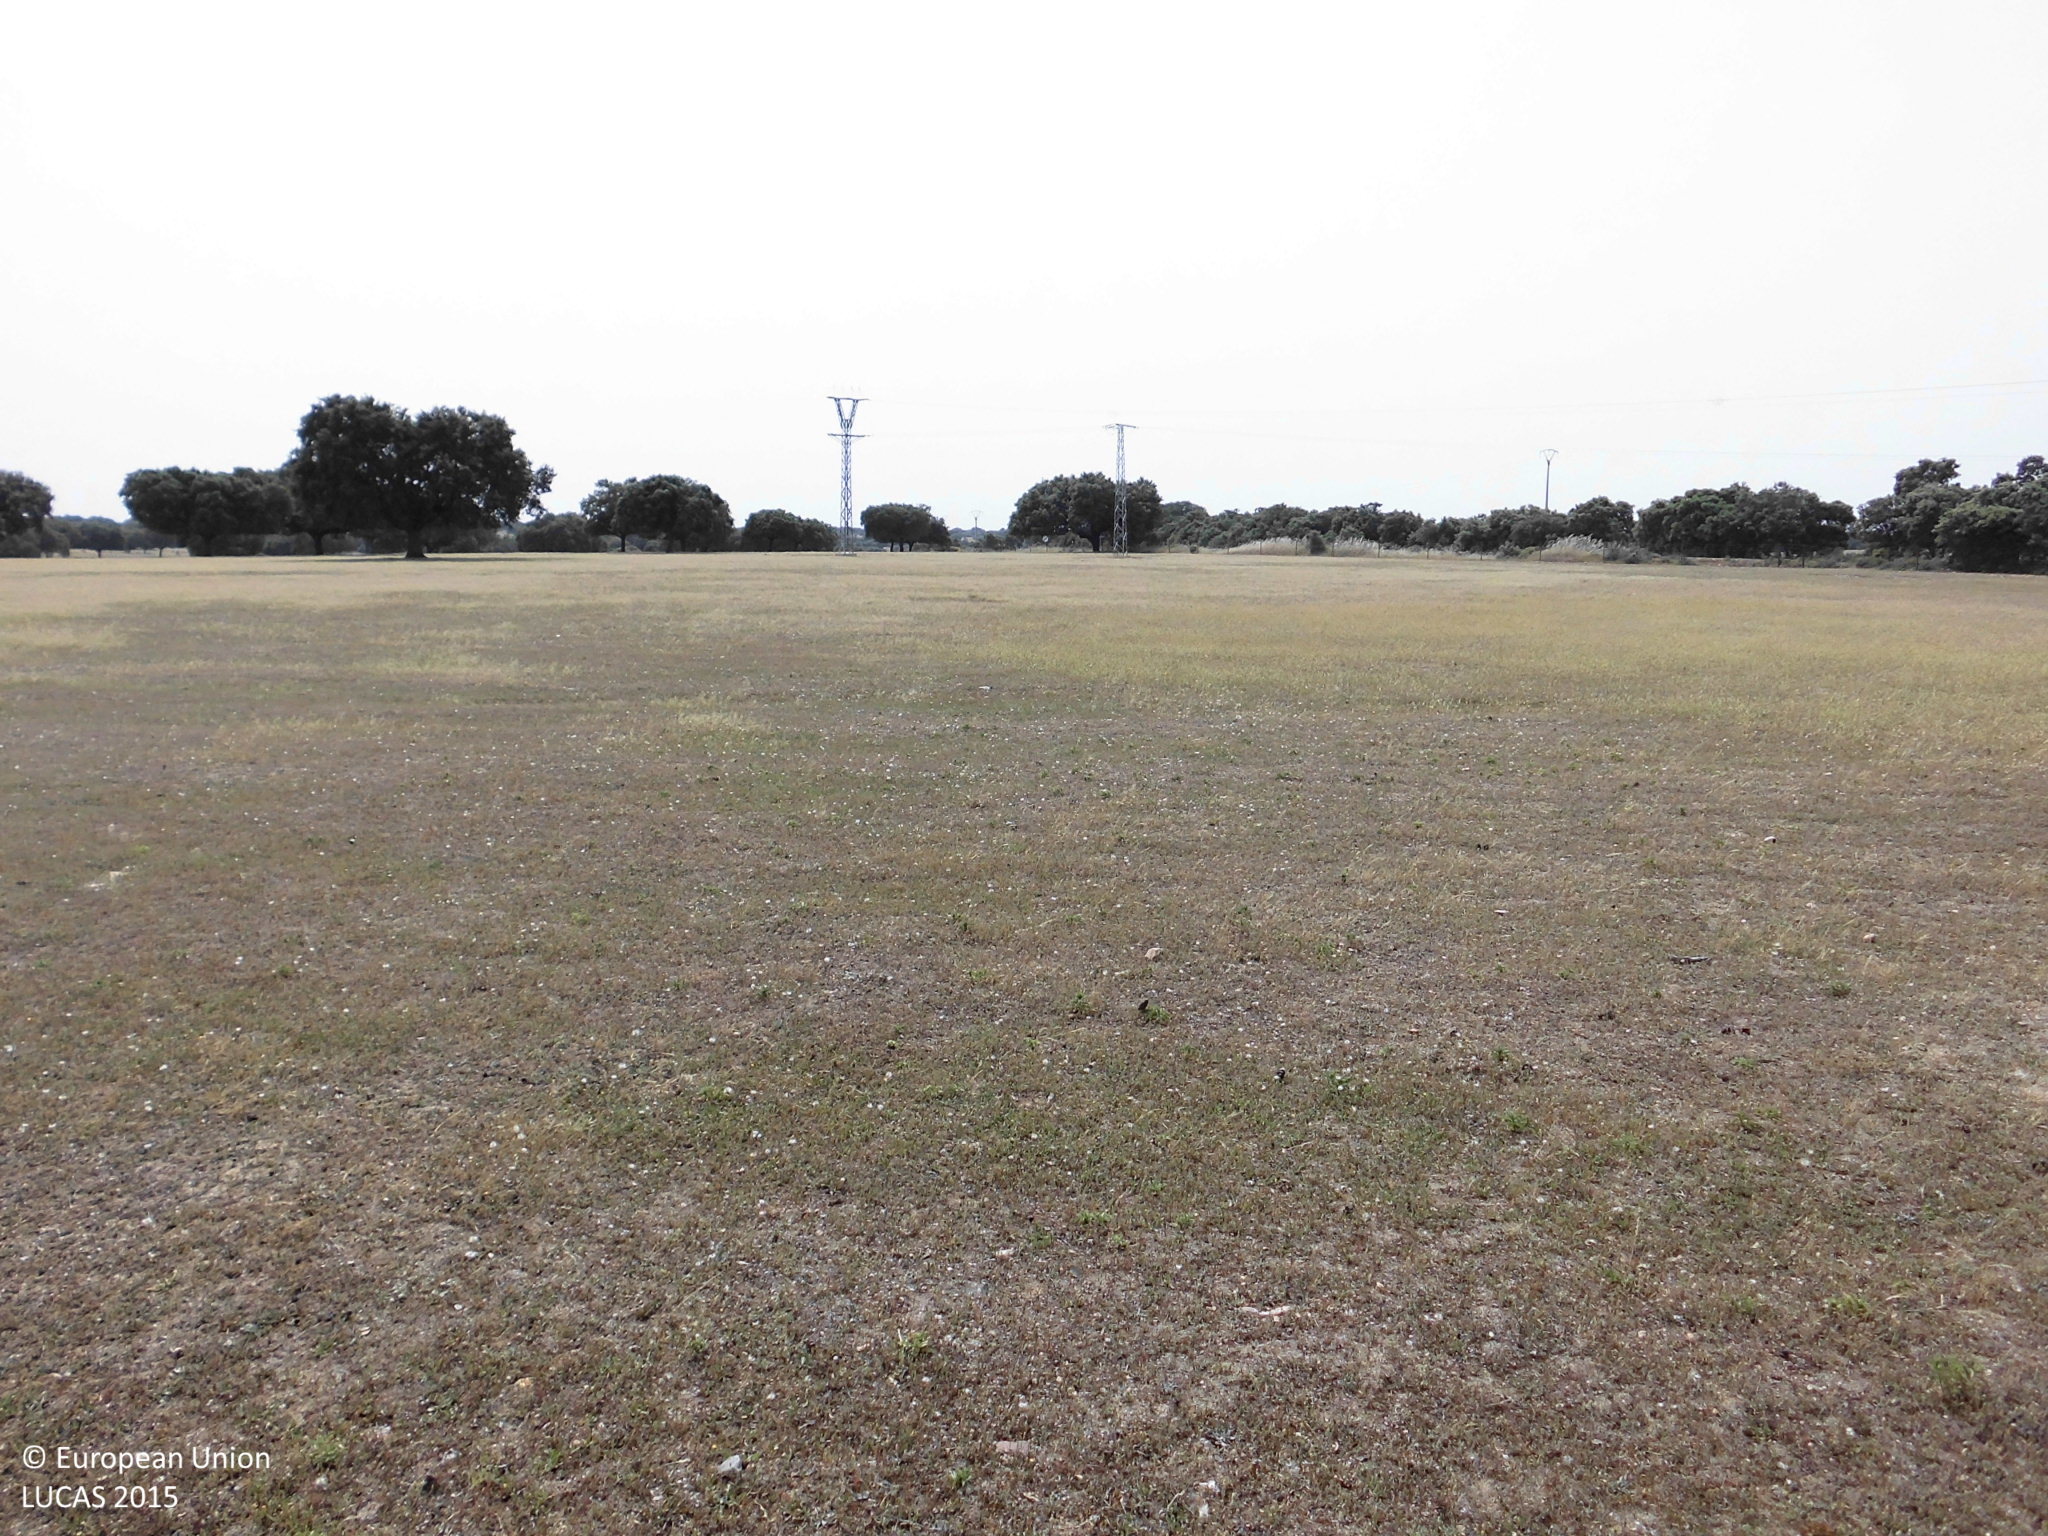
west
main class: Grassland
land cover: Grassland with sparse tree/shrub cover
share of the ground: > 75 %
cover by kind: herbaceous plants 65 %, consolidated bare surface 30 %, broadleaved forest trees 5 %
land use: Agriculture (excluding fallow land and kitchen gardens)
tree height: > 5 m
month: May
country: ES
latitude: 39.6928
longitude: -6.1480
